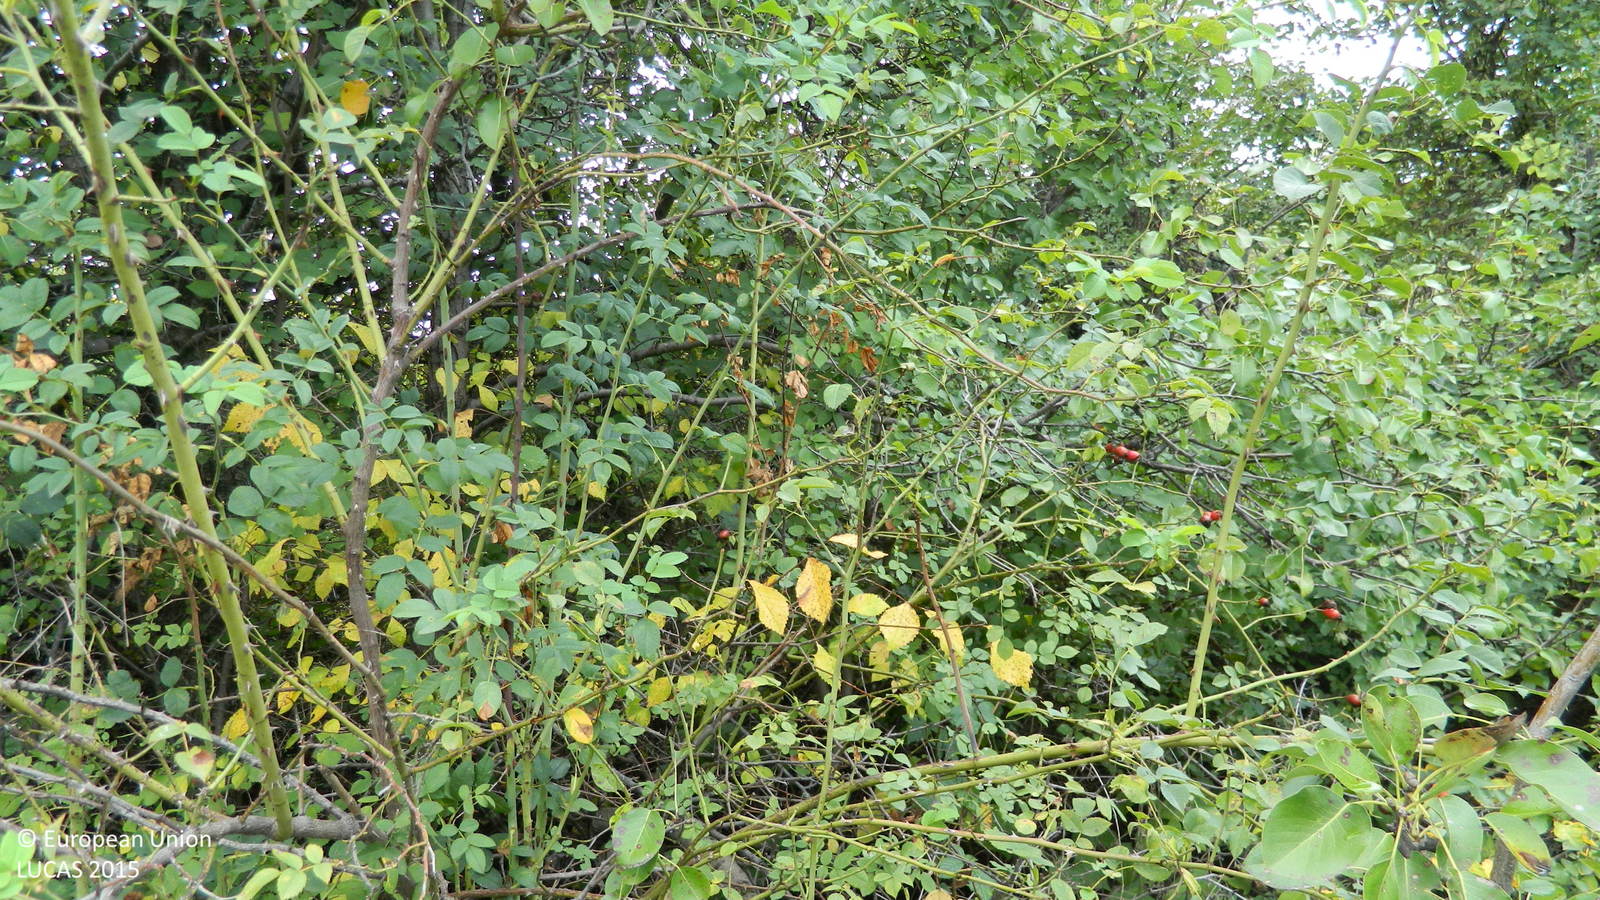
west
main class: Shrubland
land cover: Shrubland with sparse tree cover
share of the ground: > 75 %
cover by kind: shrubs 90 %, broadleaved forest trees 5 %, herbaceous plants 5 %
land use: Semi-natural and natural areas not in use
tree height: > 5 m
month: October
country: BG
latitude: 41.7979
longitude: 25.4038
